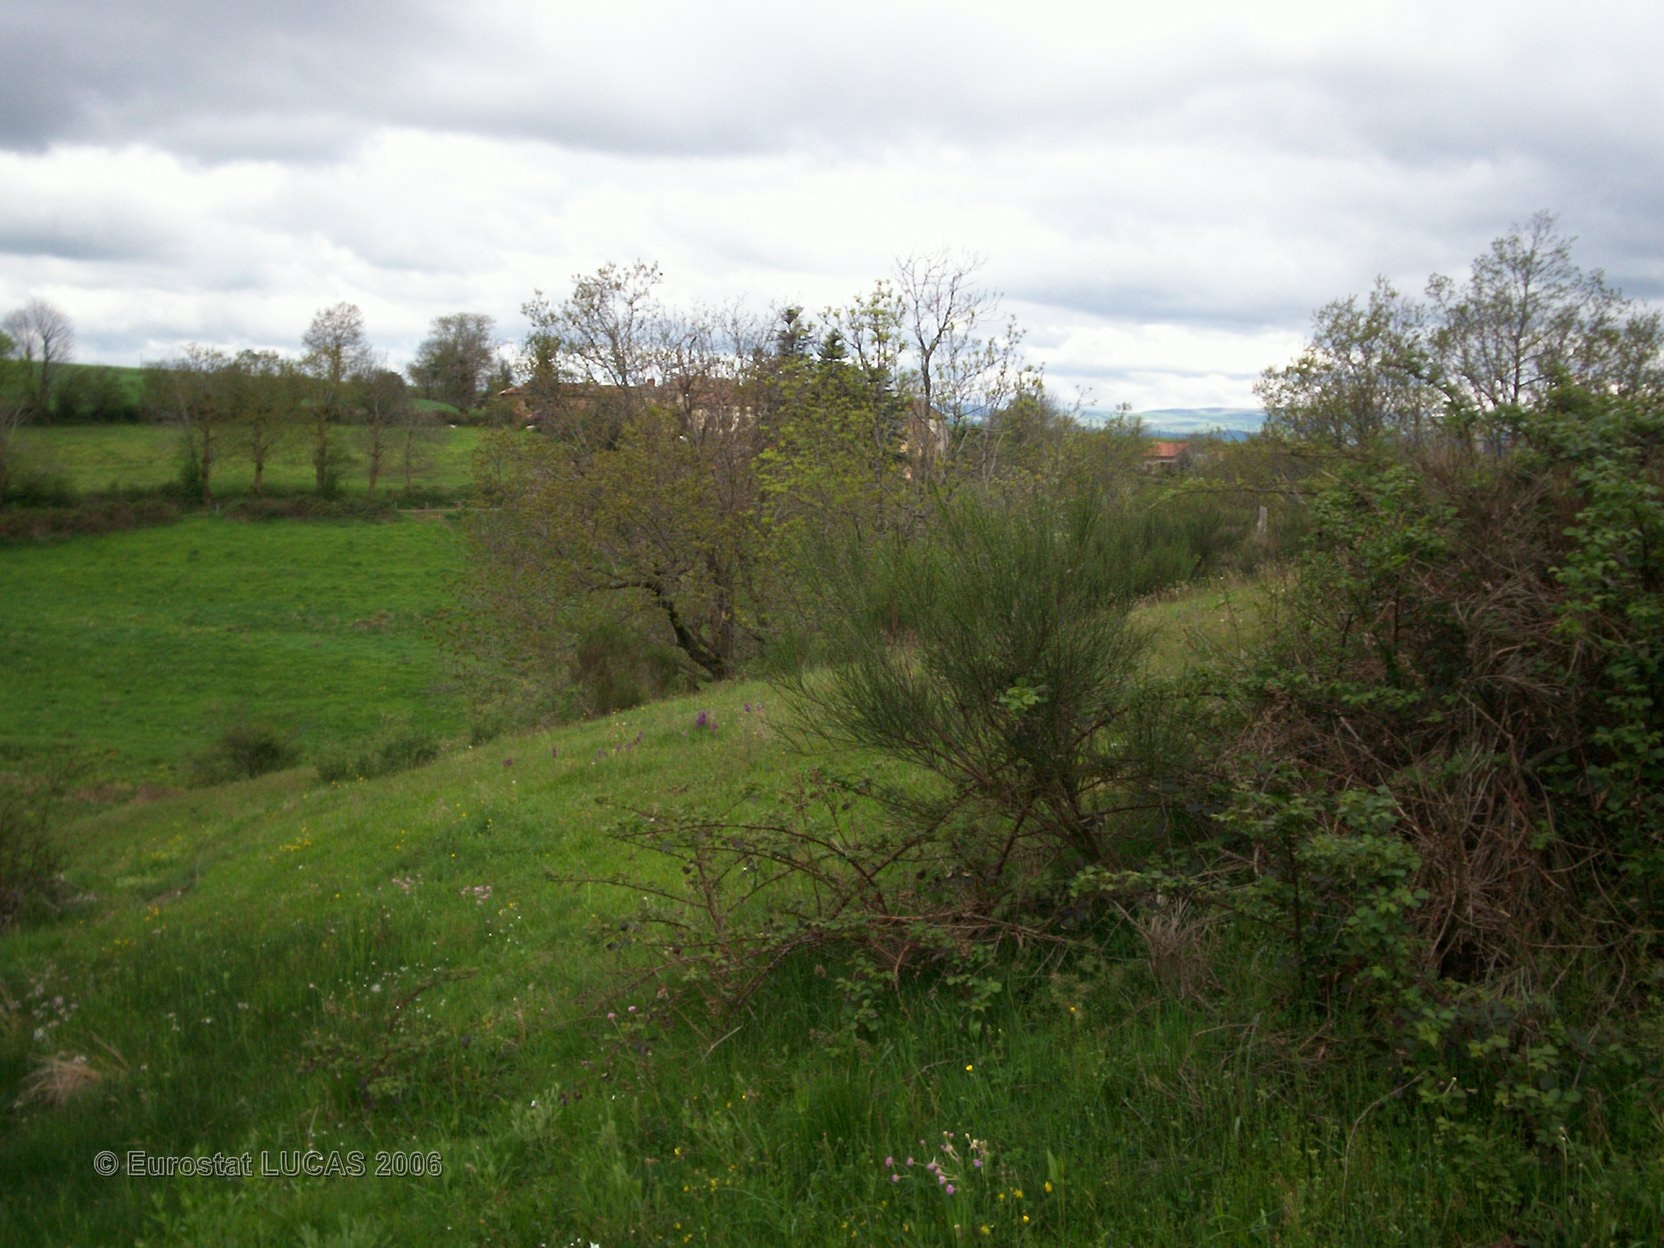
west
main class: Grassland
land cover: Grassland without tree/shrub cover
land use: Agriculture (excluding fallow land and kitchen gardens)
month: May
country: FR
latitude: 45.2154
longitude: 3.2405
